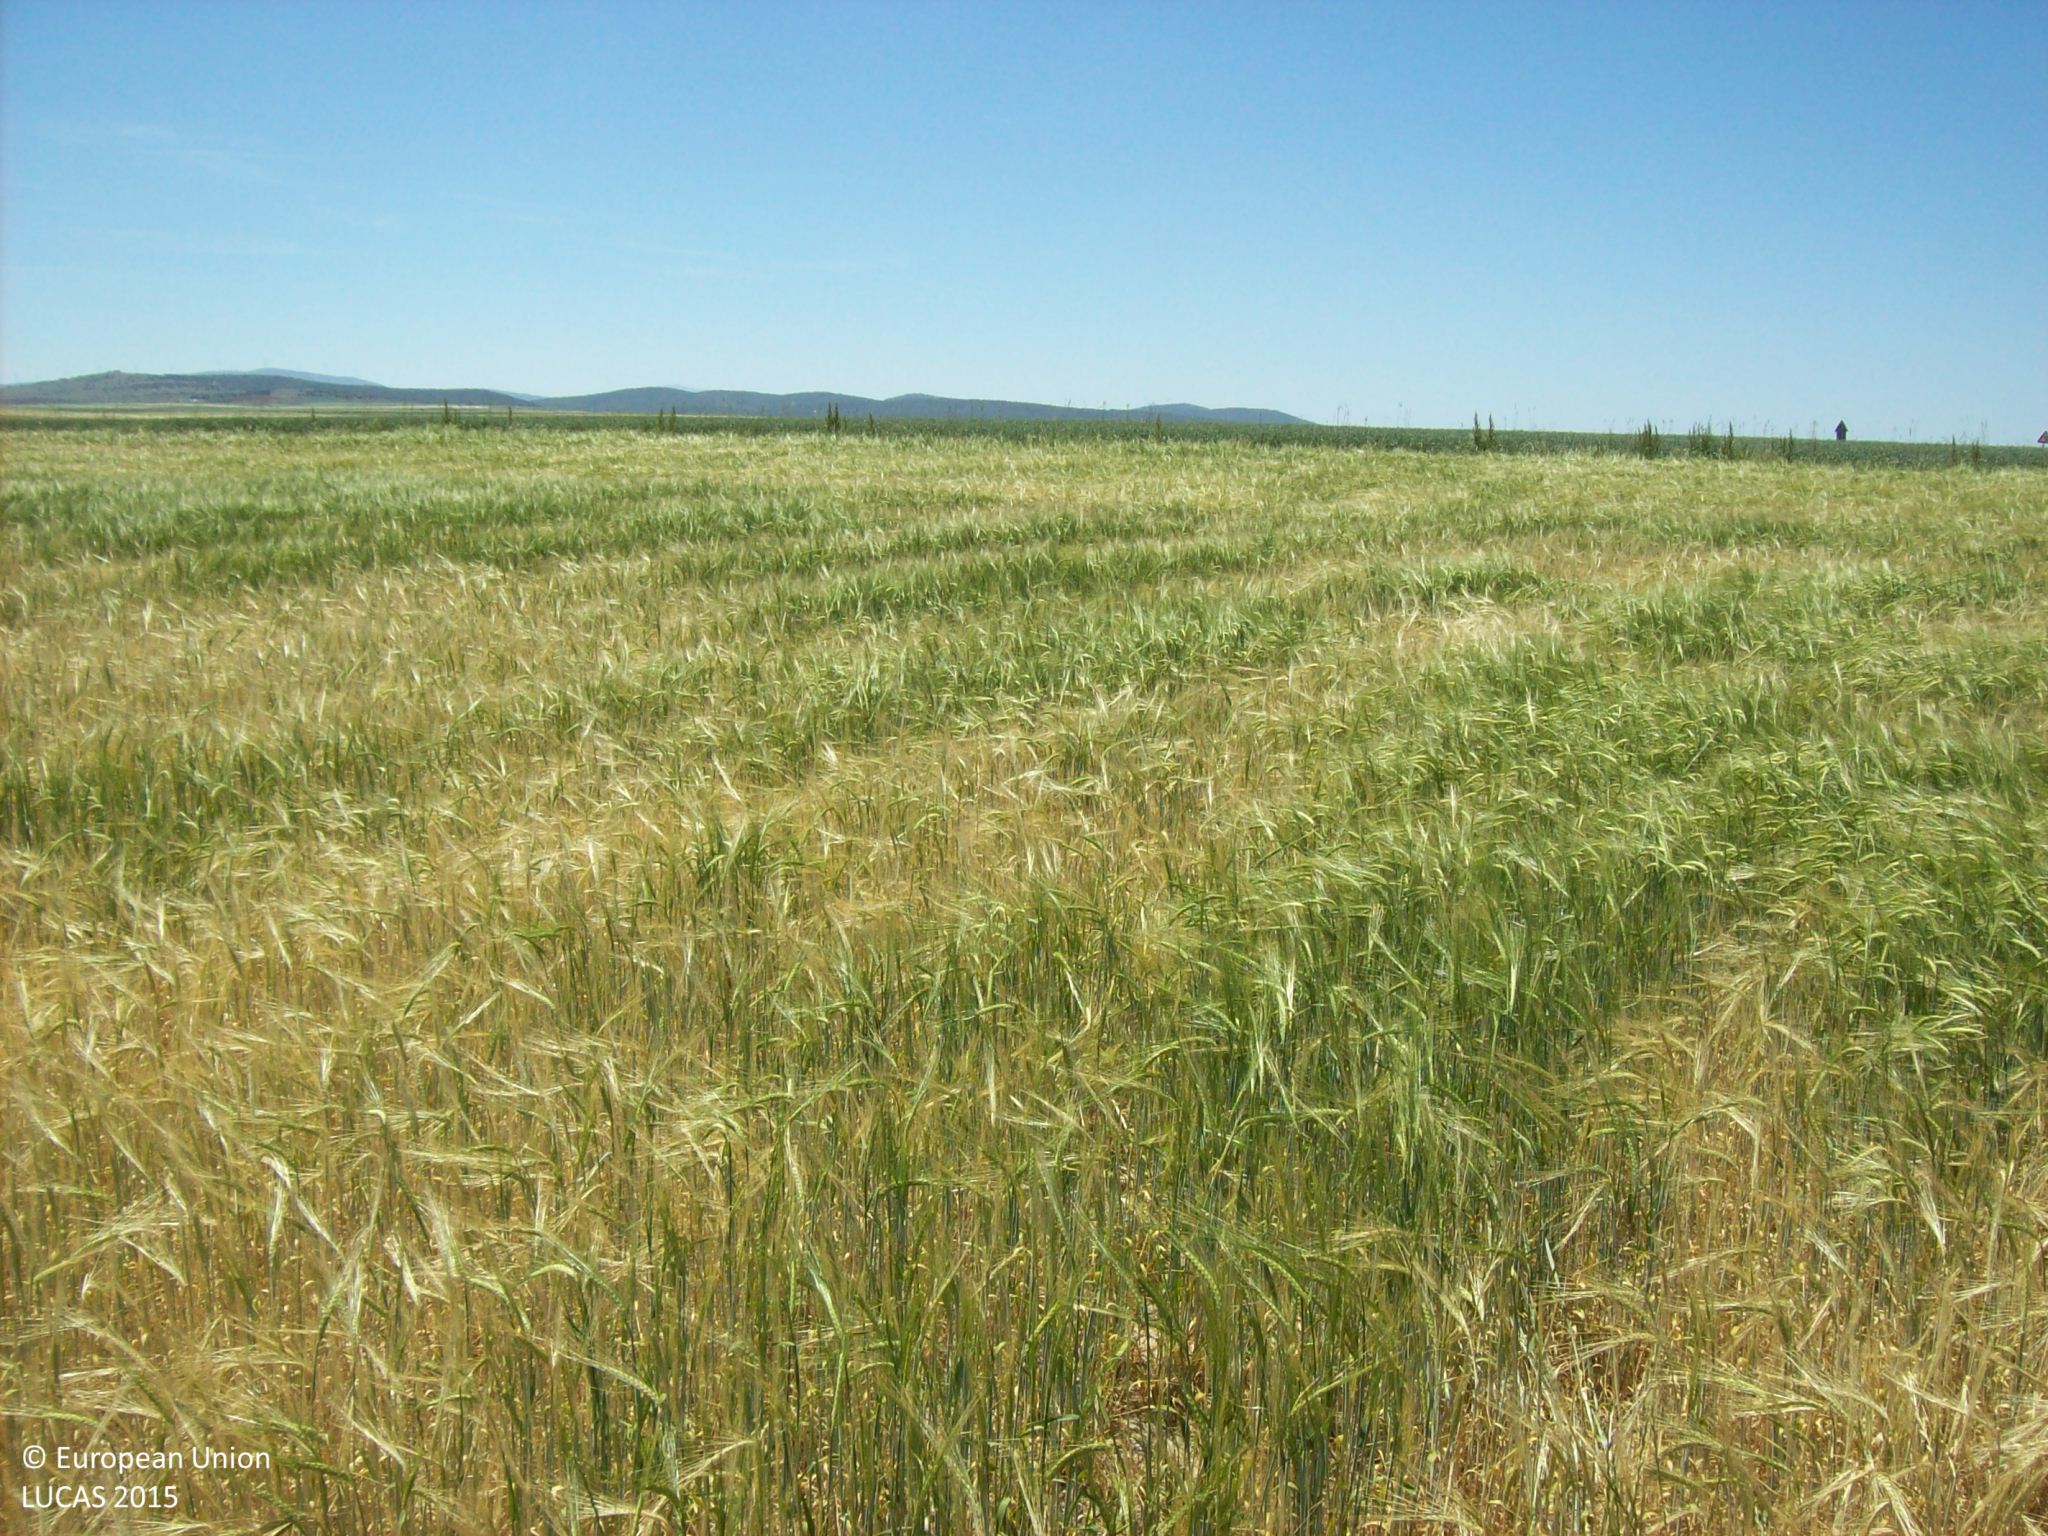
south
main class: Cropland
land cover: Barley
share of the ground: > 75 %
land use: Agriculture (excluding fallow land and kitchen gardens)
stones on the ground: < 10 %
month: May
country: ES
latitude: 40.8372
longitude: -4.9698
